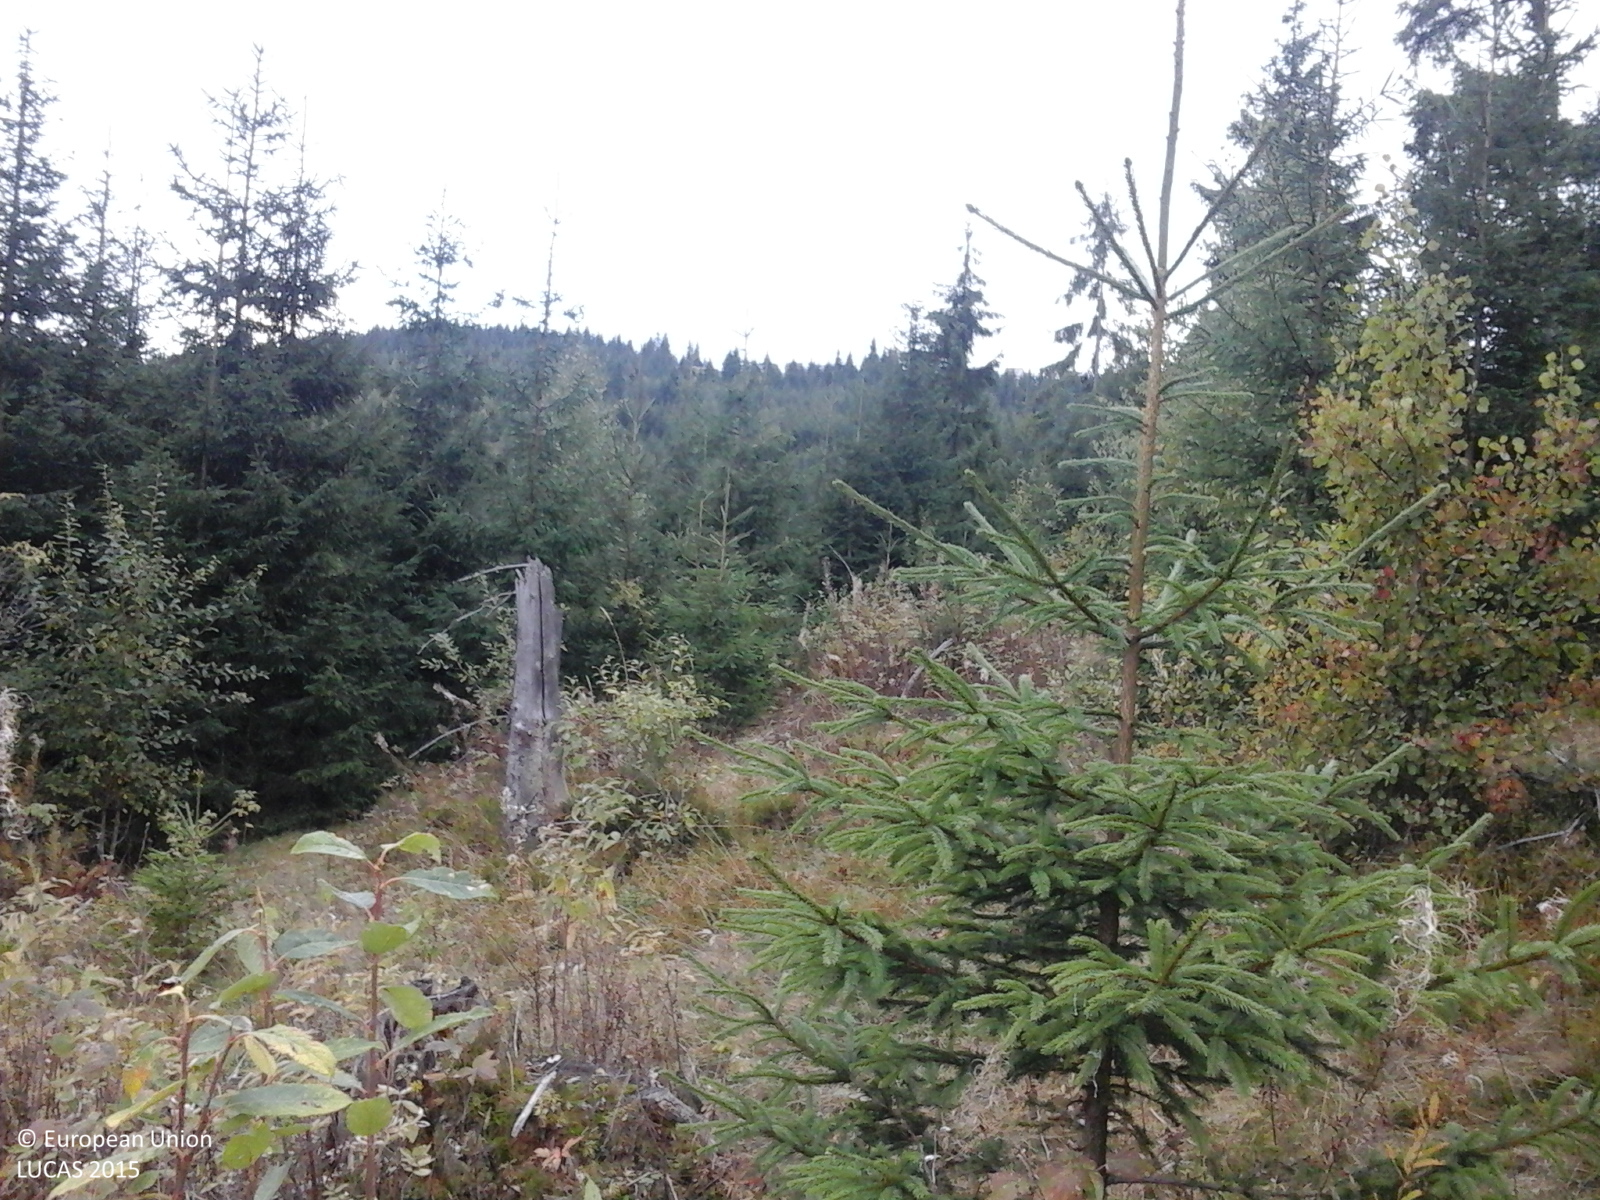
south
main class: Woodland
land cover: Spruce dominated mixed woodland
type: alpine coniferous forest
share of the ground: > 75 %
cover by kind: coniferous forest trees 70 %, broadleaved forest trees 30 %
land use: Forestry
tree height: > 5 m
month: October
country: RO
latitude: 46.5925
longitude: 23.1539
